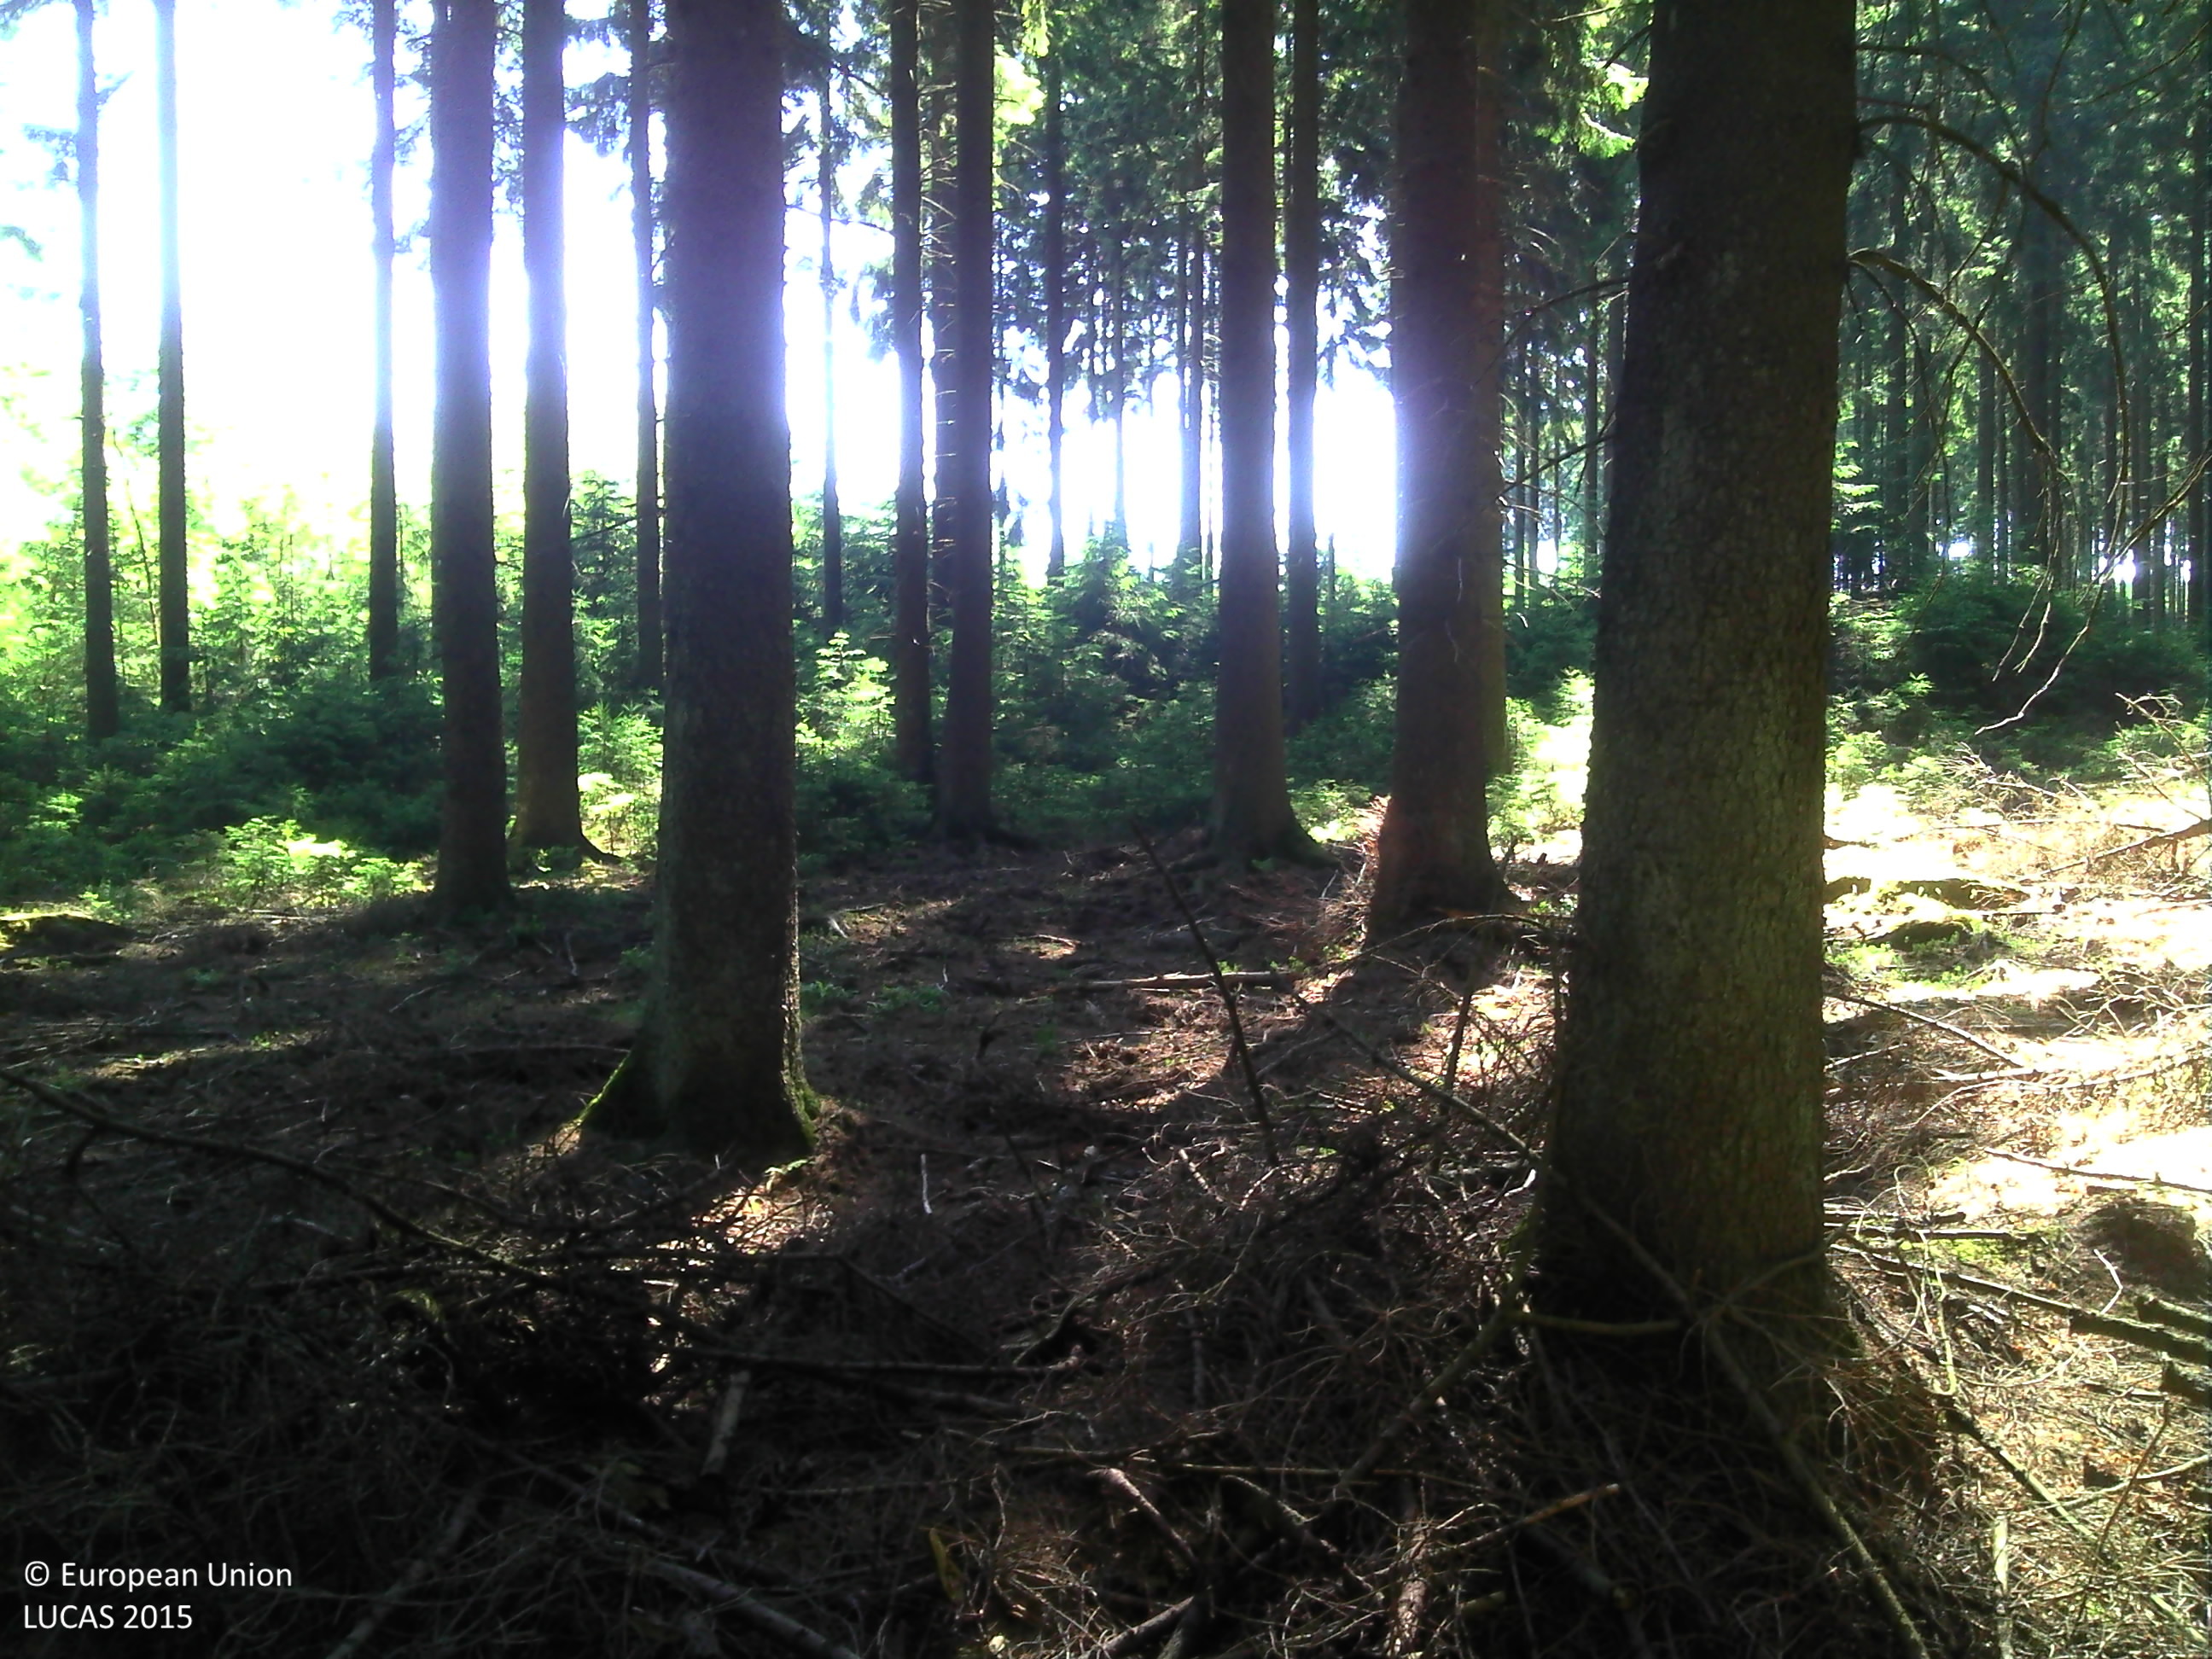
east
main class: Woodland
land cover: Spruce dominated coniferous woodland
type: exotic forest
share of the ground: > 75 %
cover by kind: coniferous forest trees 95 %, lichens and mosses 5 %
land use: Forestry
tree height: > 5 m
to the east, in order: Spruce dominated coniferous woodland; Ditches and canals; Tracks; Spruce dominated coniferous woodland; Ditches and canals; Spruce dominated coniferous woodland; Ditches and canals; Spruce dominated coniferous woodland; Ditches and canals; Spruce dominated coniferous woodland; Ditches and canals; Spruce dominated coniferous woodland; Grass margins
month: June
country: BE
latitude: 50.4486
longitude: 5.7879
